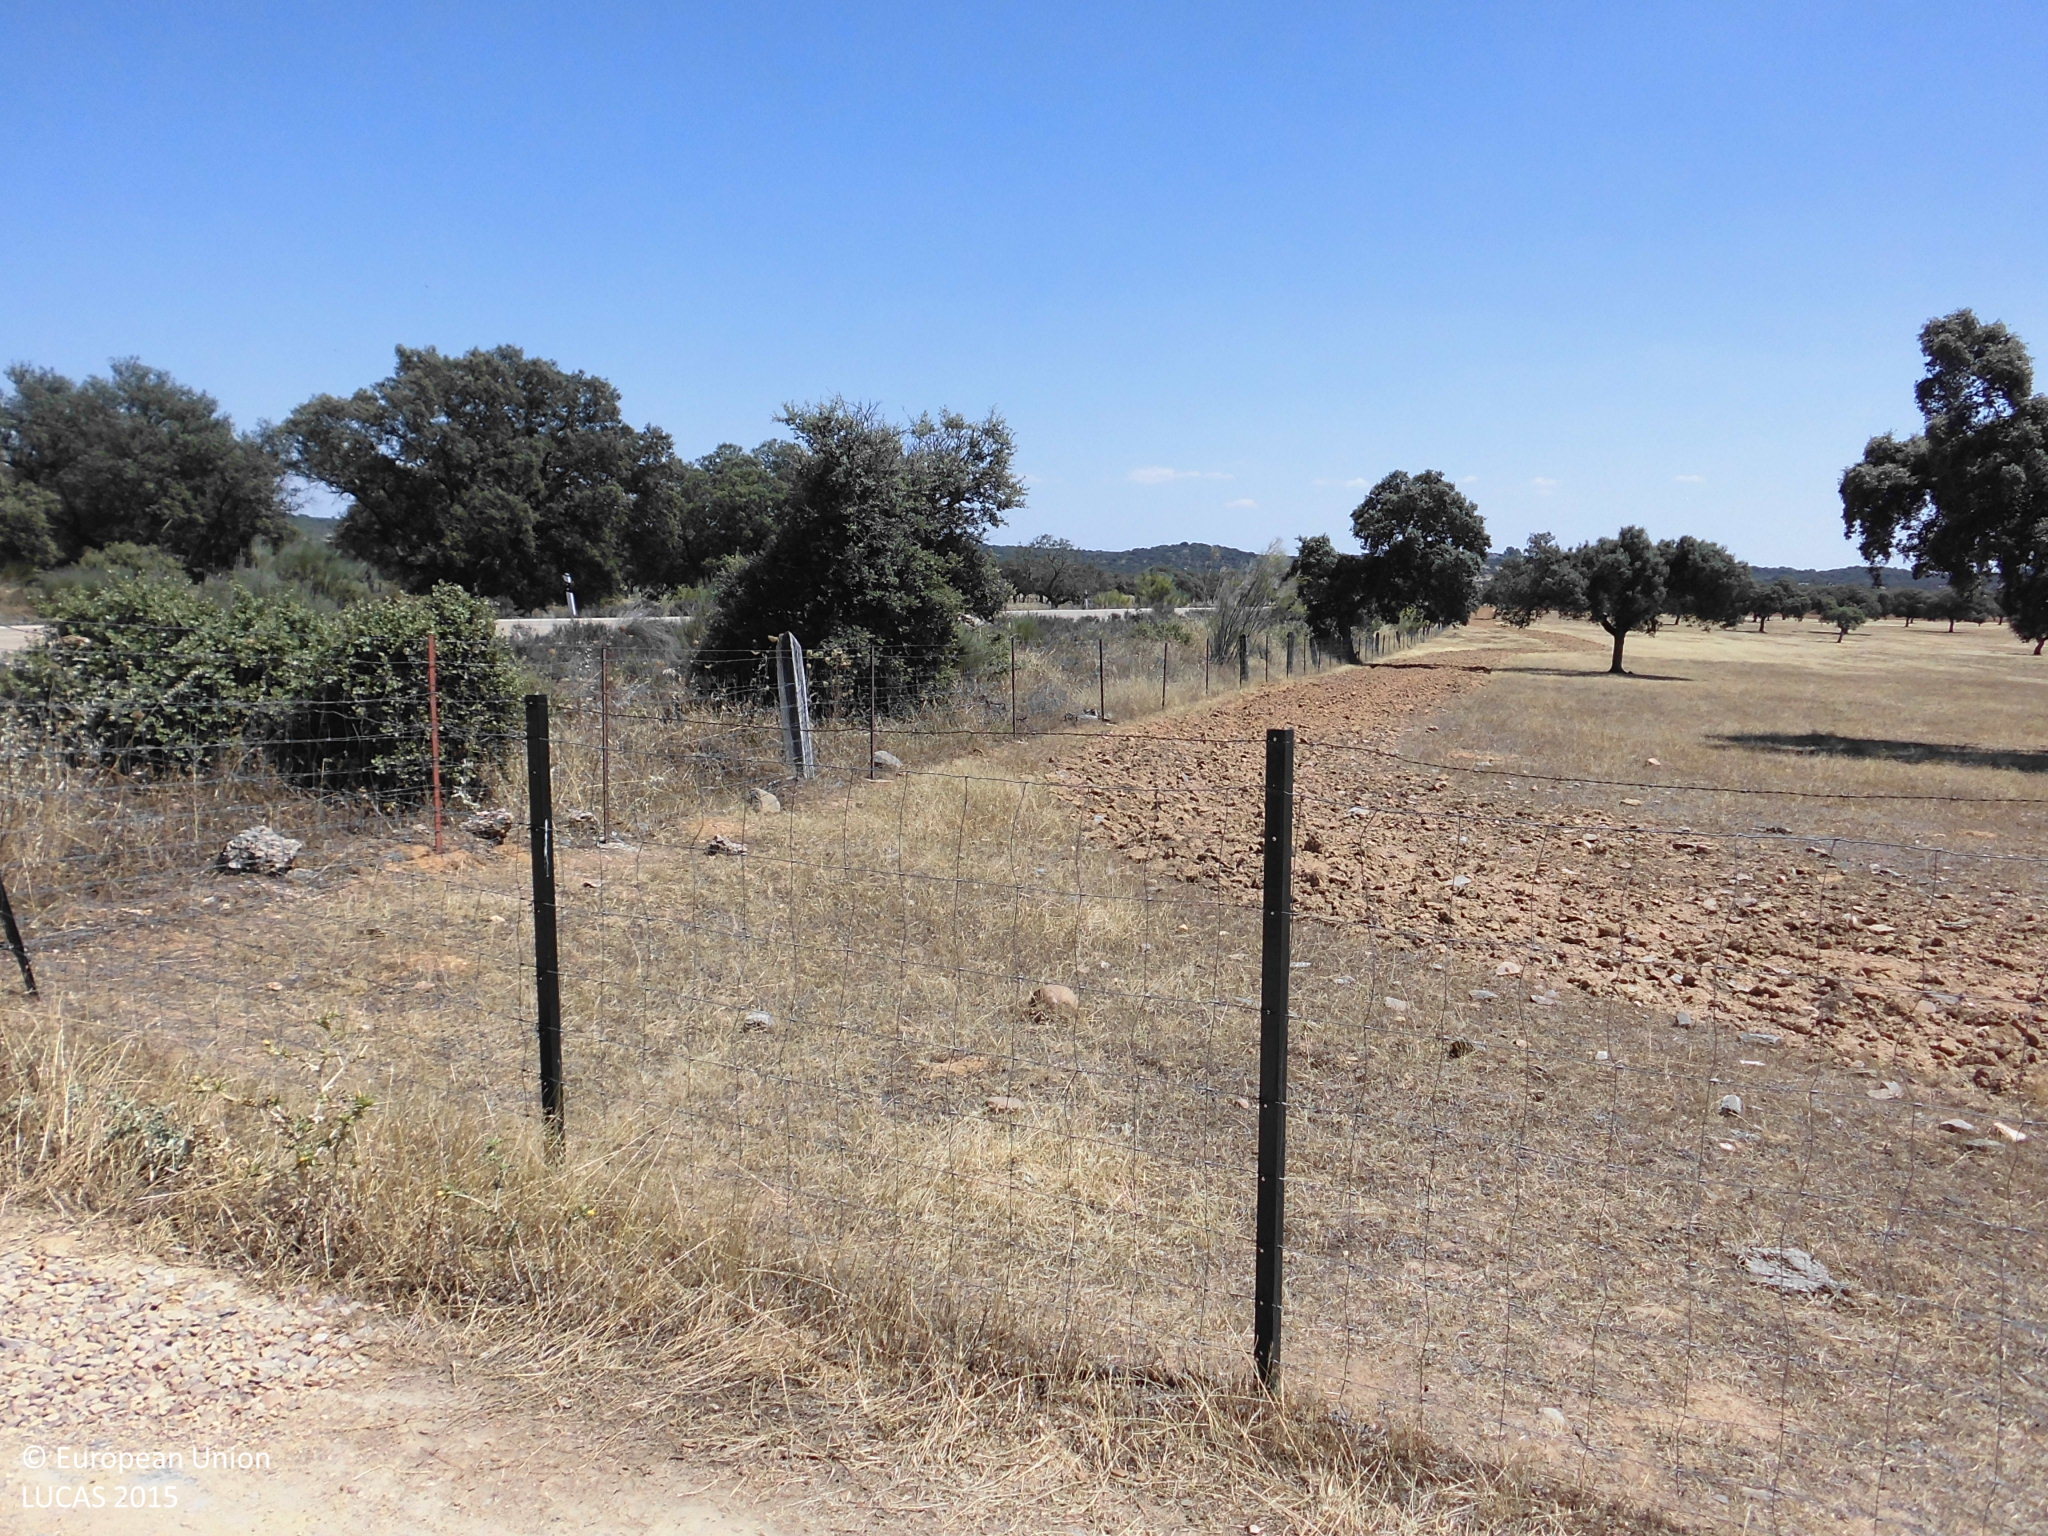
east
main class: Woodland
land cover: Broadleaved woodland
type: broadleaved evergreen forest
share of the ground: 10 - 25 %
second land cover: Grassland without tree/shrub cover
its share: > 75 %
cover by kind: herbaceous plants 80 %, broadleaved forest trees 20 %
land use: Forestry
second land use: Agriculture (excluding fallow land and kitchen gardens)
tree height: > 5 m
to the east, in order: Broadleaved woodland; Grassland without tree/shrub cover
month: June
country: ES
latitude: 39.7334
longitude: -6.0154
